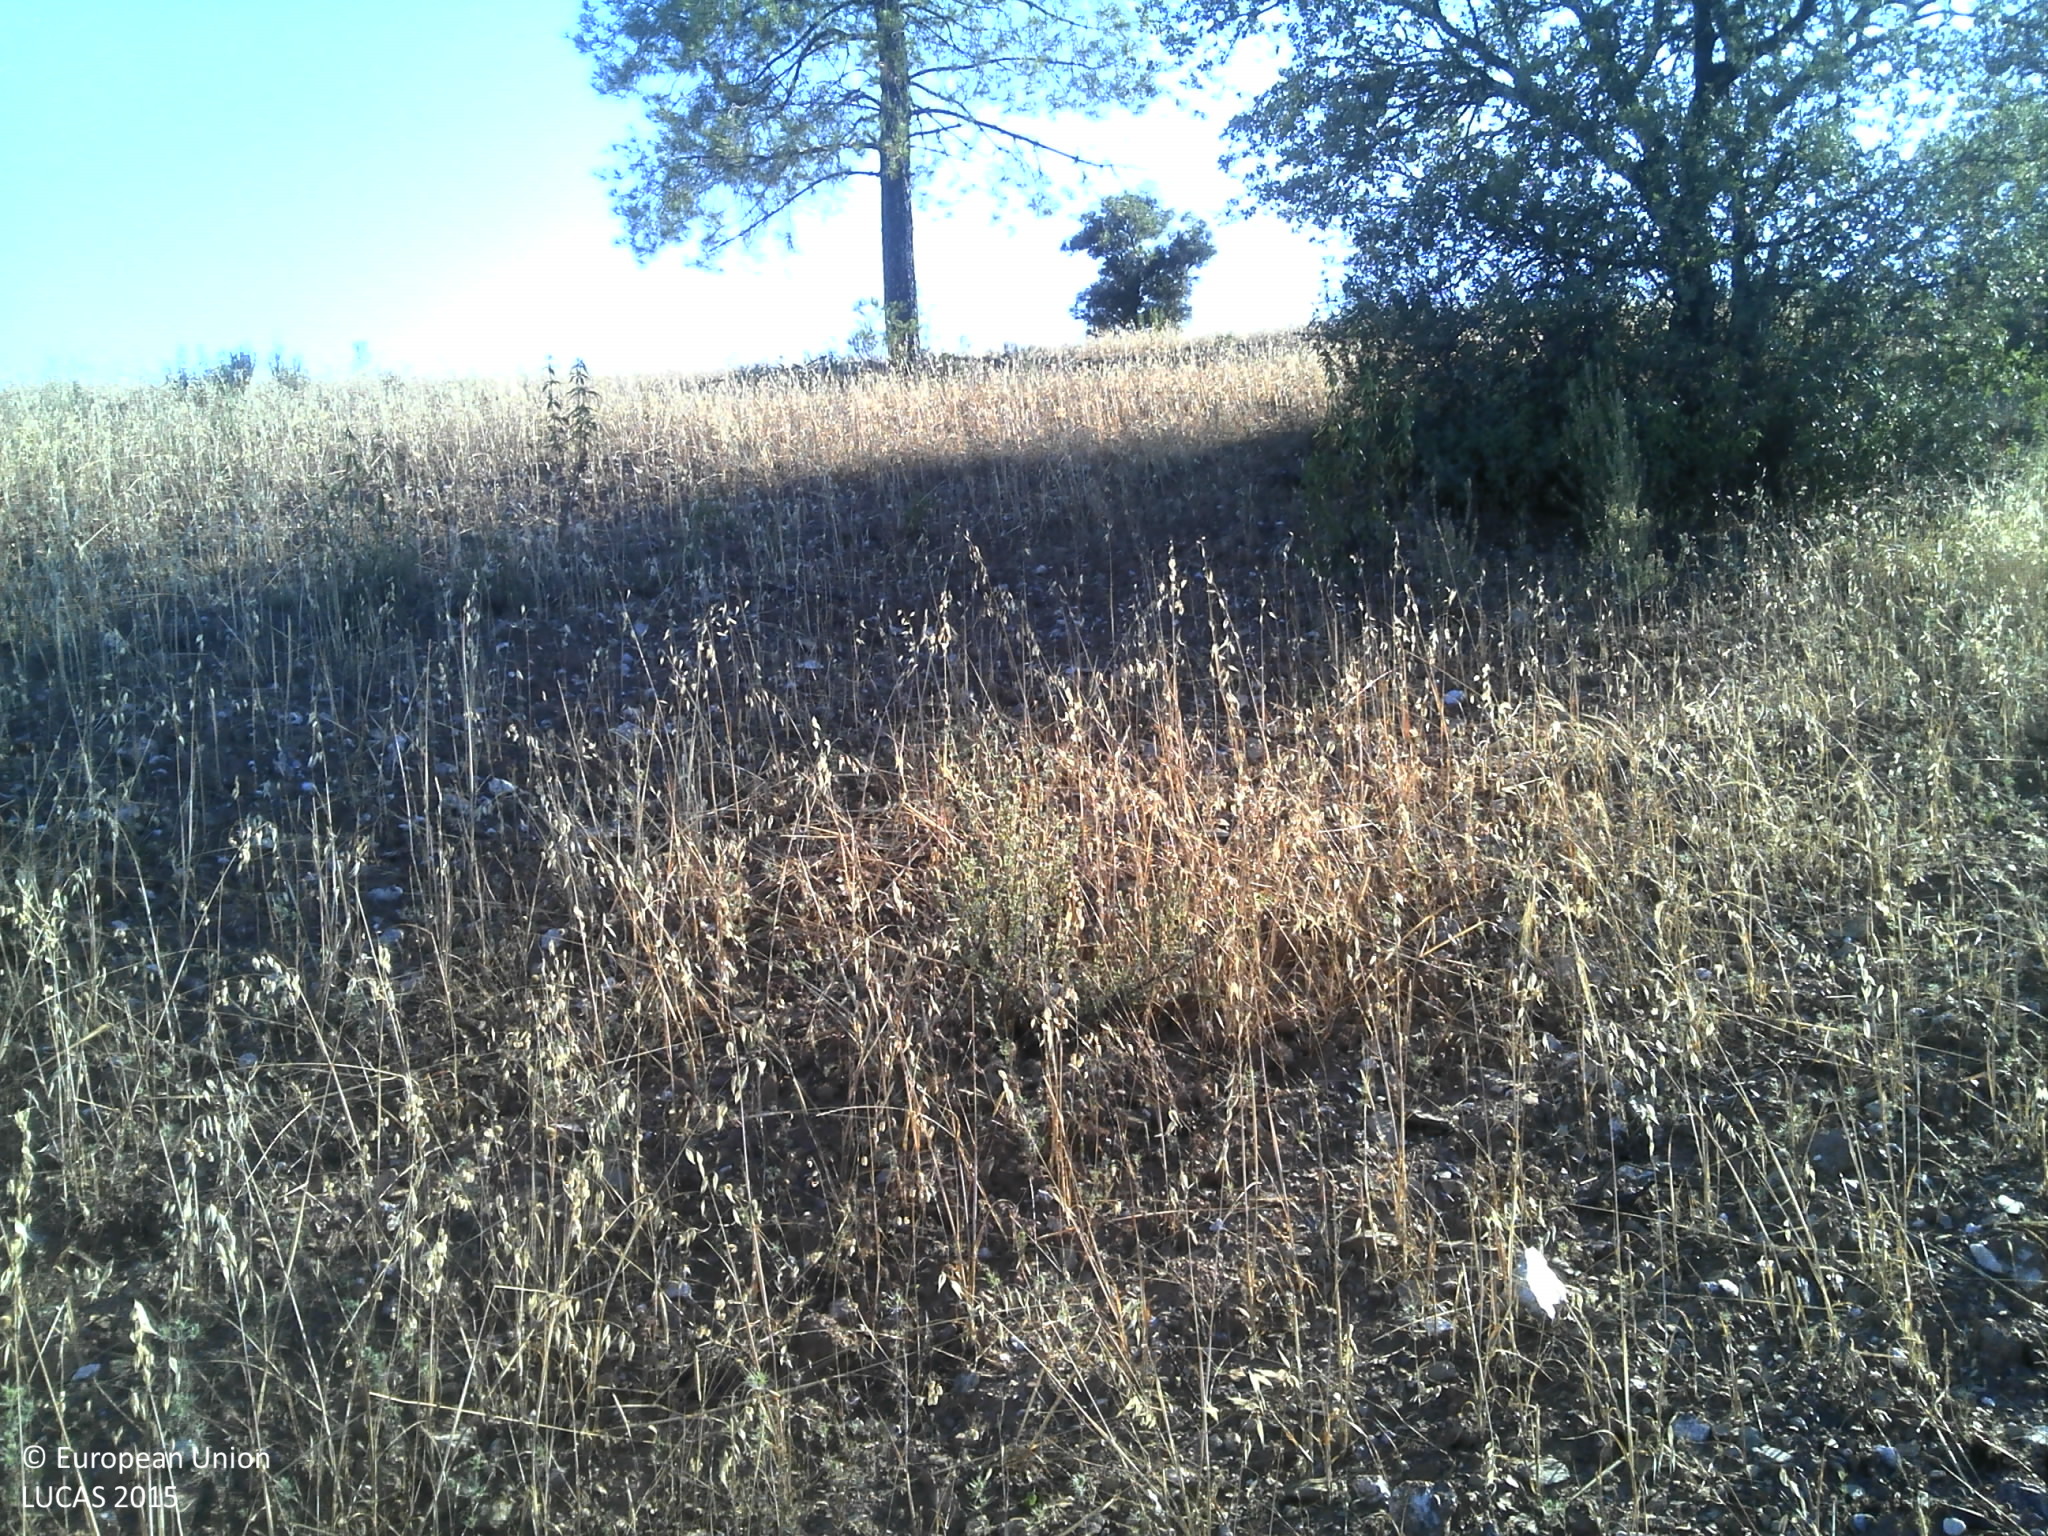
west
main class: Shrubland
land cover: Shrubland with sparse tree cover
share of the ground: 50 - 75 %
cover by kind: shrubs 75 %, herbaceous plants 10 %, coniferous forest trees 5 %, unconsolidated bare surface 5 %
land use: Forestry
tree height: > 5 m
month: June
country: PT
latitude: 39.9524
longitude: -7.0995
